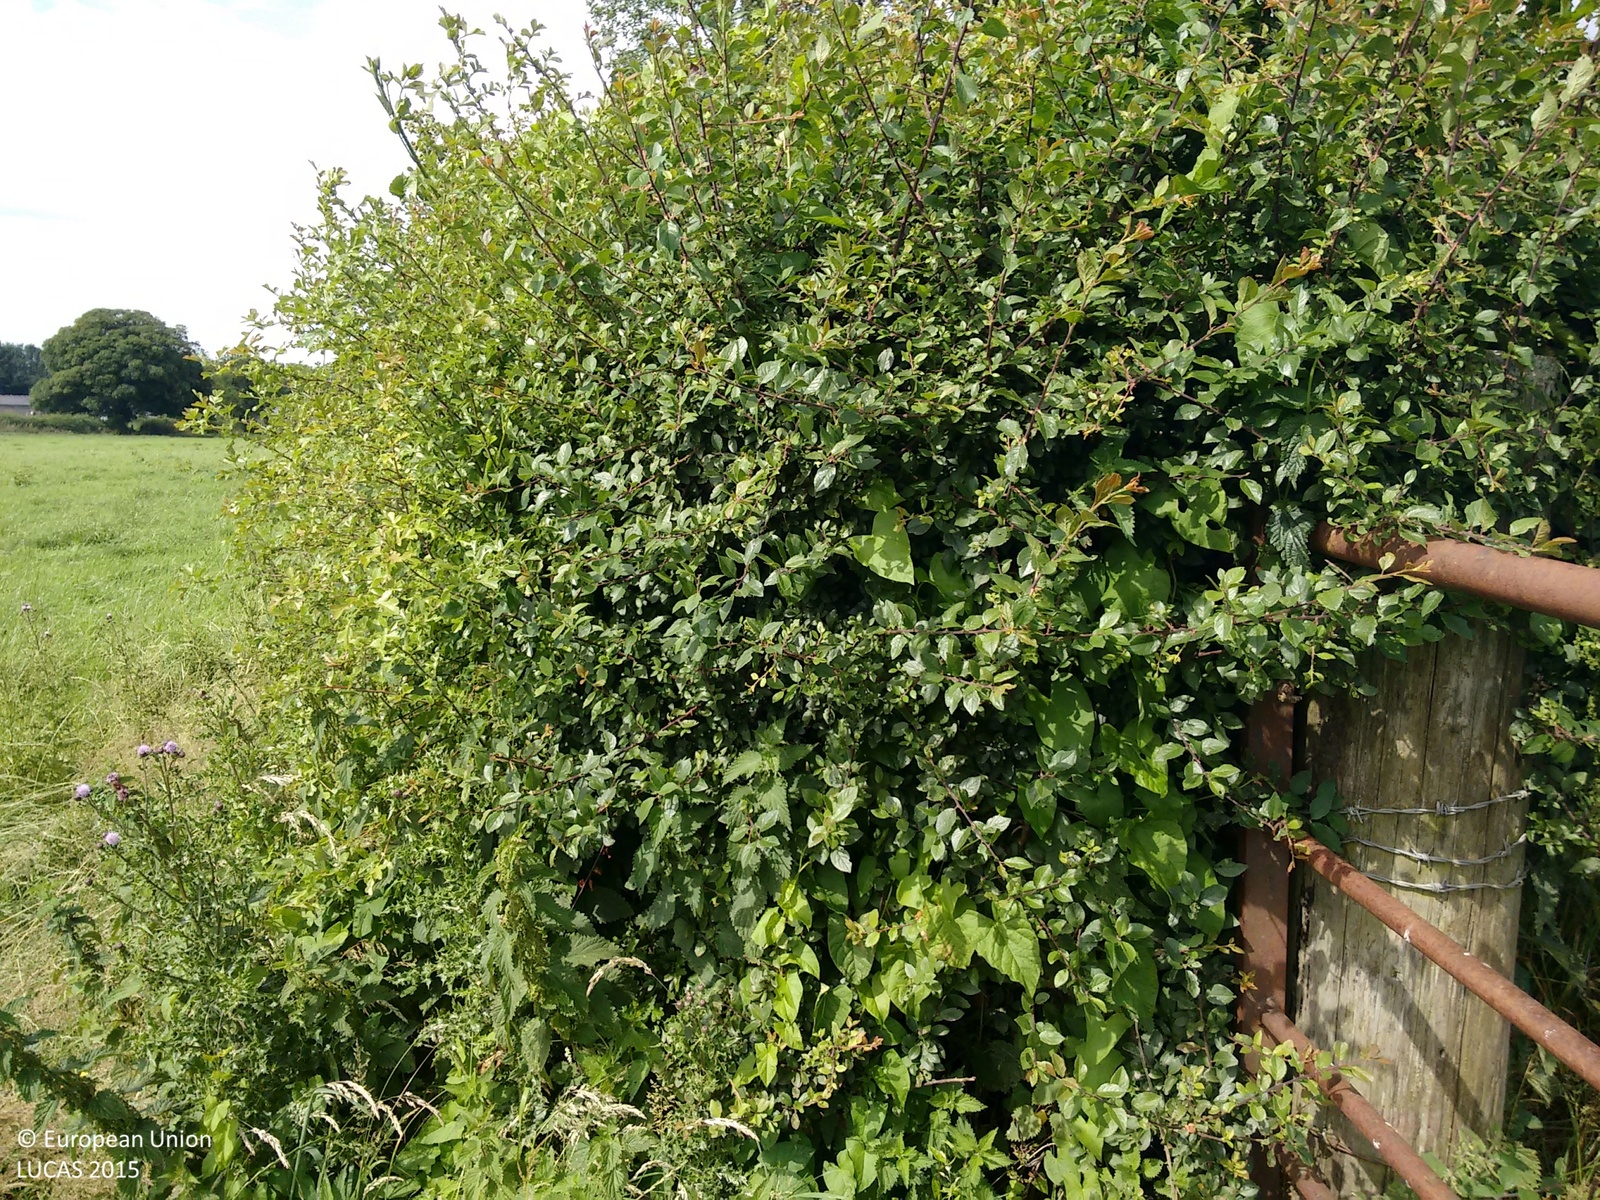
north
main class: Grassland
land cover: Grassland without tree/shrub cover
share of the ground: > 75 %
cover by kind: herbaceous plants 100 %
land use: Agriculture (excluding fallow land and kitchen gardens)
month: July
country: GB
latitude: 51.2565
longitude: -2.5187
